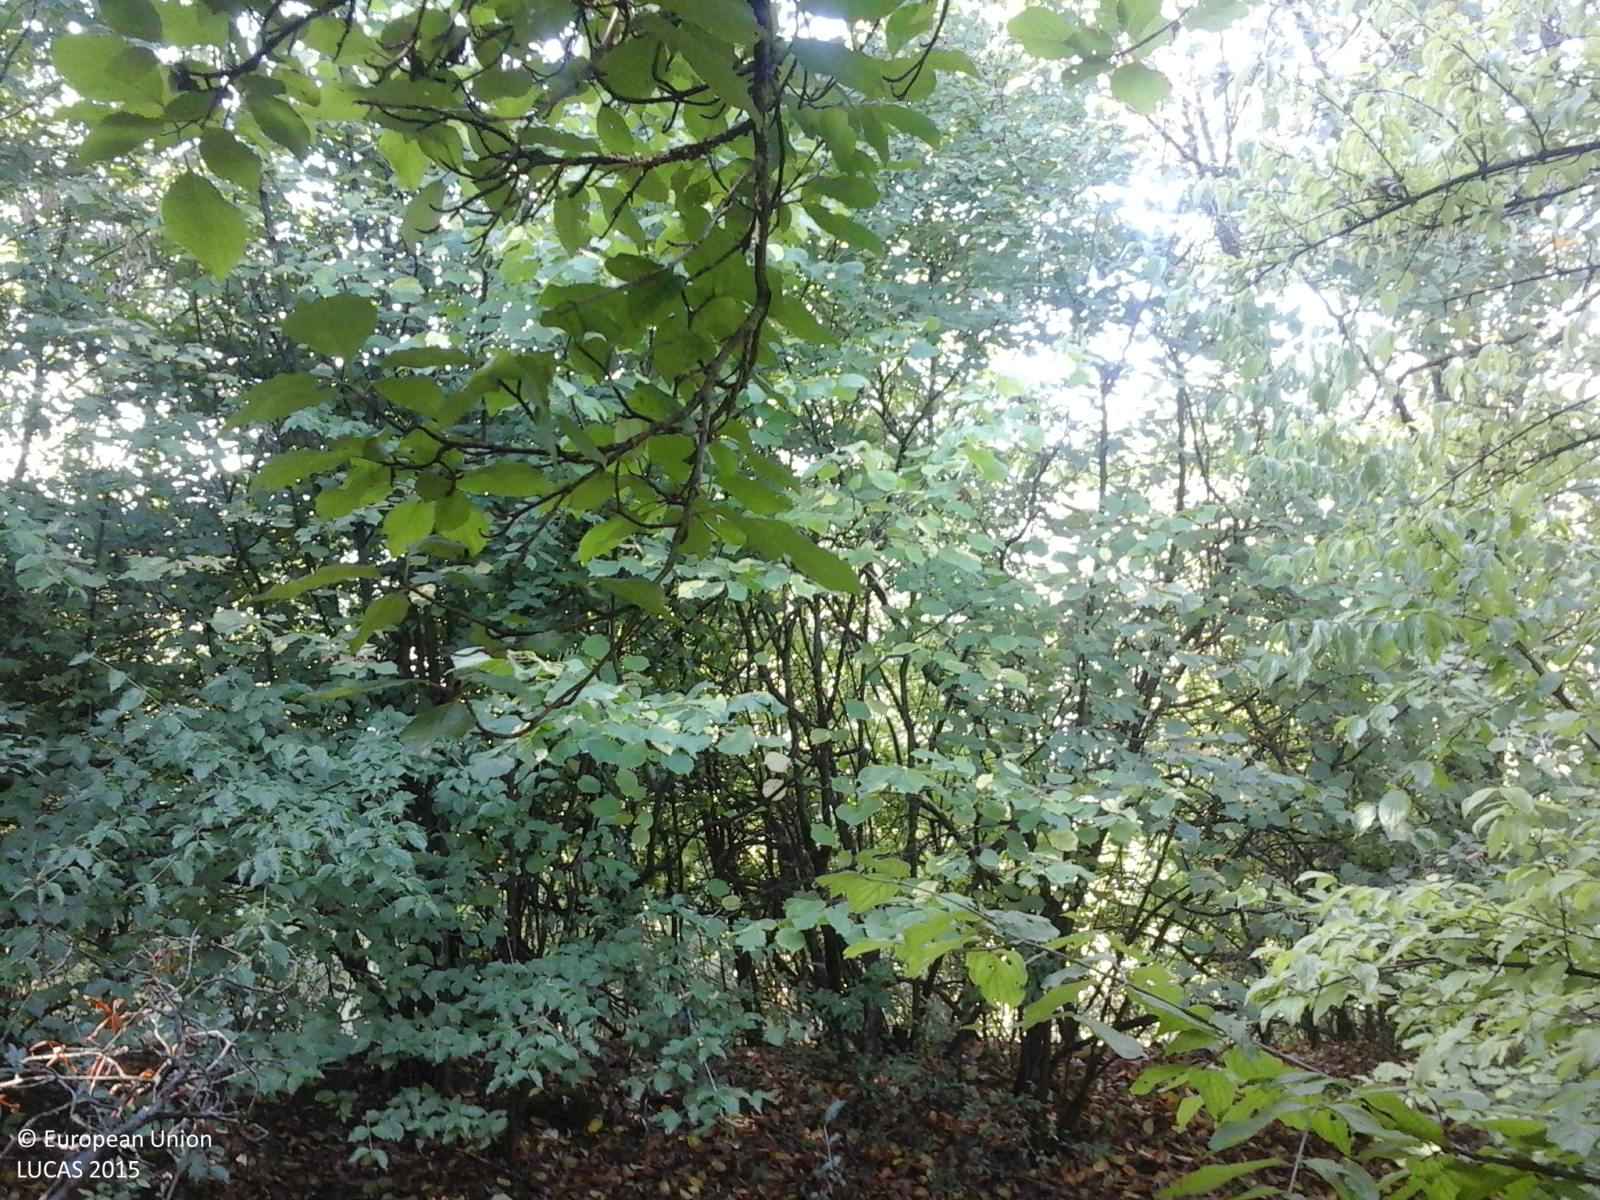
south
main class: Woodland
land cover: Broadleaved woodland
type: beech forest
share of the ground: > 75 %
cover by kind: broadleaved forest trees 100 %
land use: Forestry
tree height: > 5 m
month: September
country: RO
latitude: 47.3638
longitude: 23.4051
